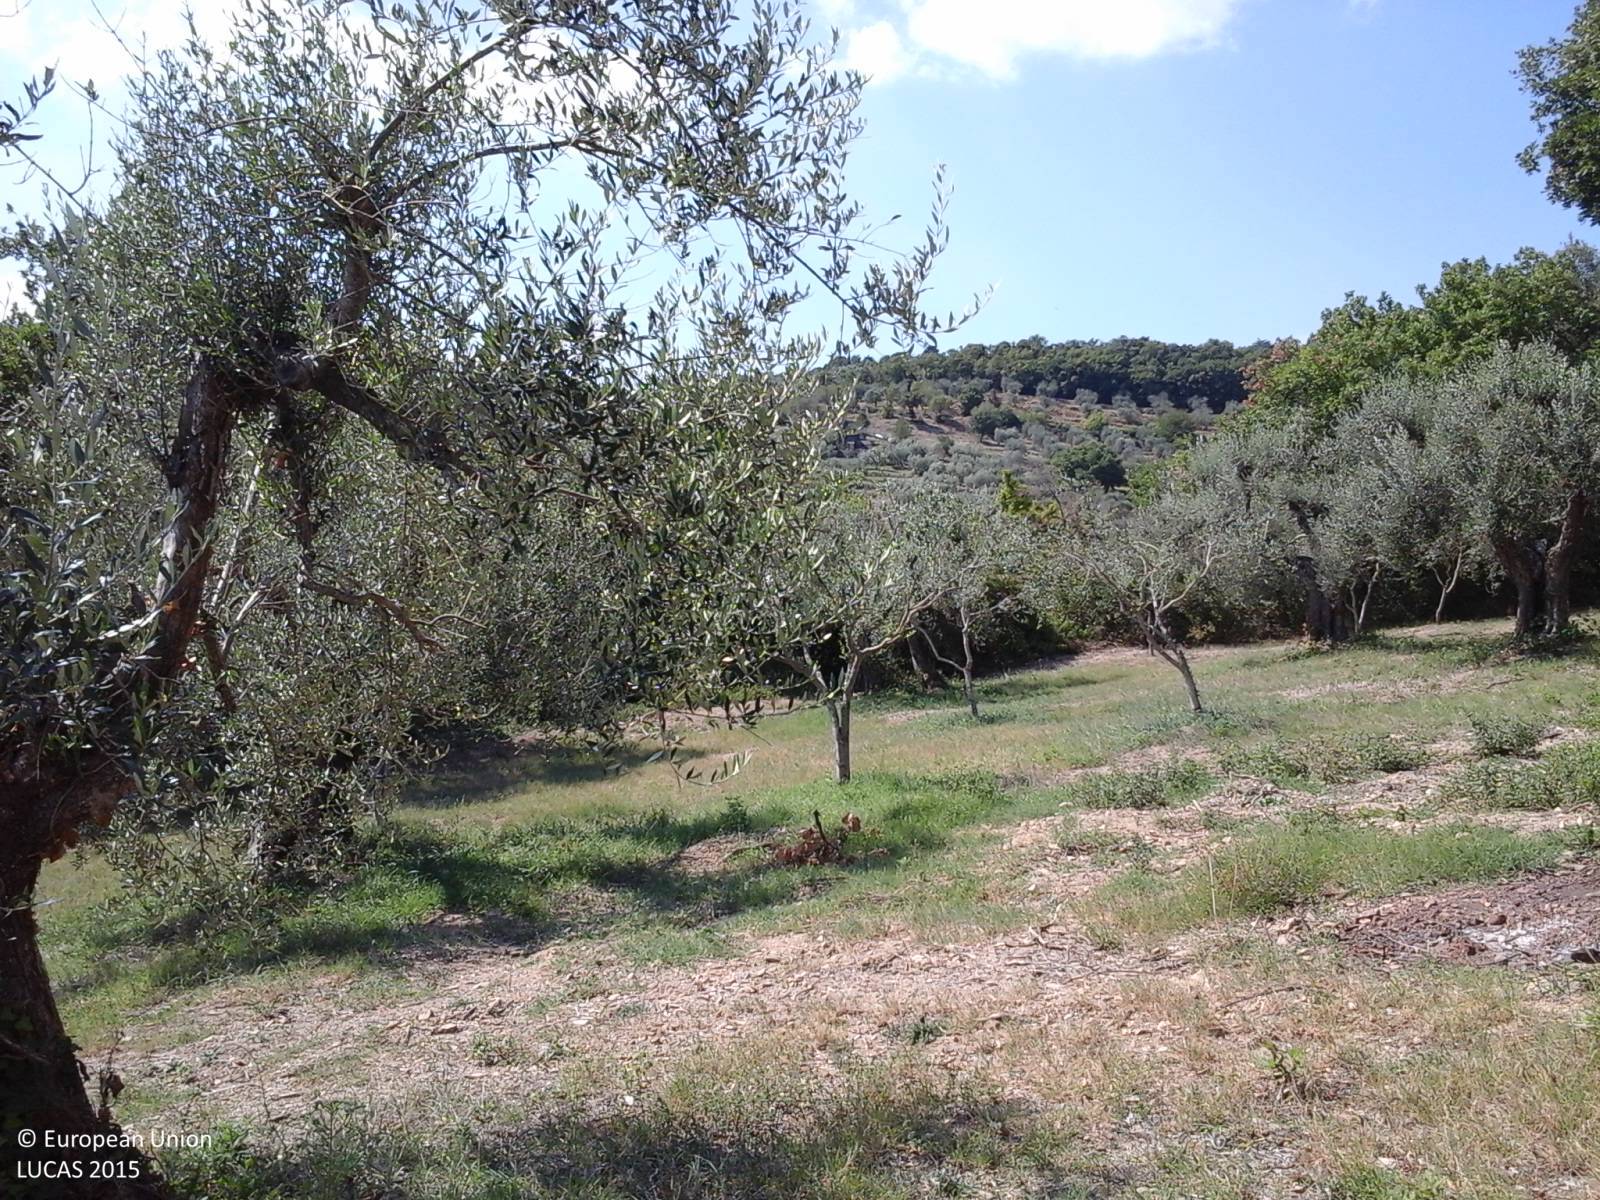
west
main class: Cropland
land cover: Olive groves
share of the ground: 25 - 50 %
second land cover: Grassland without tree/shrub cover
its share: > 75 %
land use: Agriculture (excluding fallow land and kitchen gardens)
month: September
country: IT
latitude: 43.1164
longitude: 12.2670
